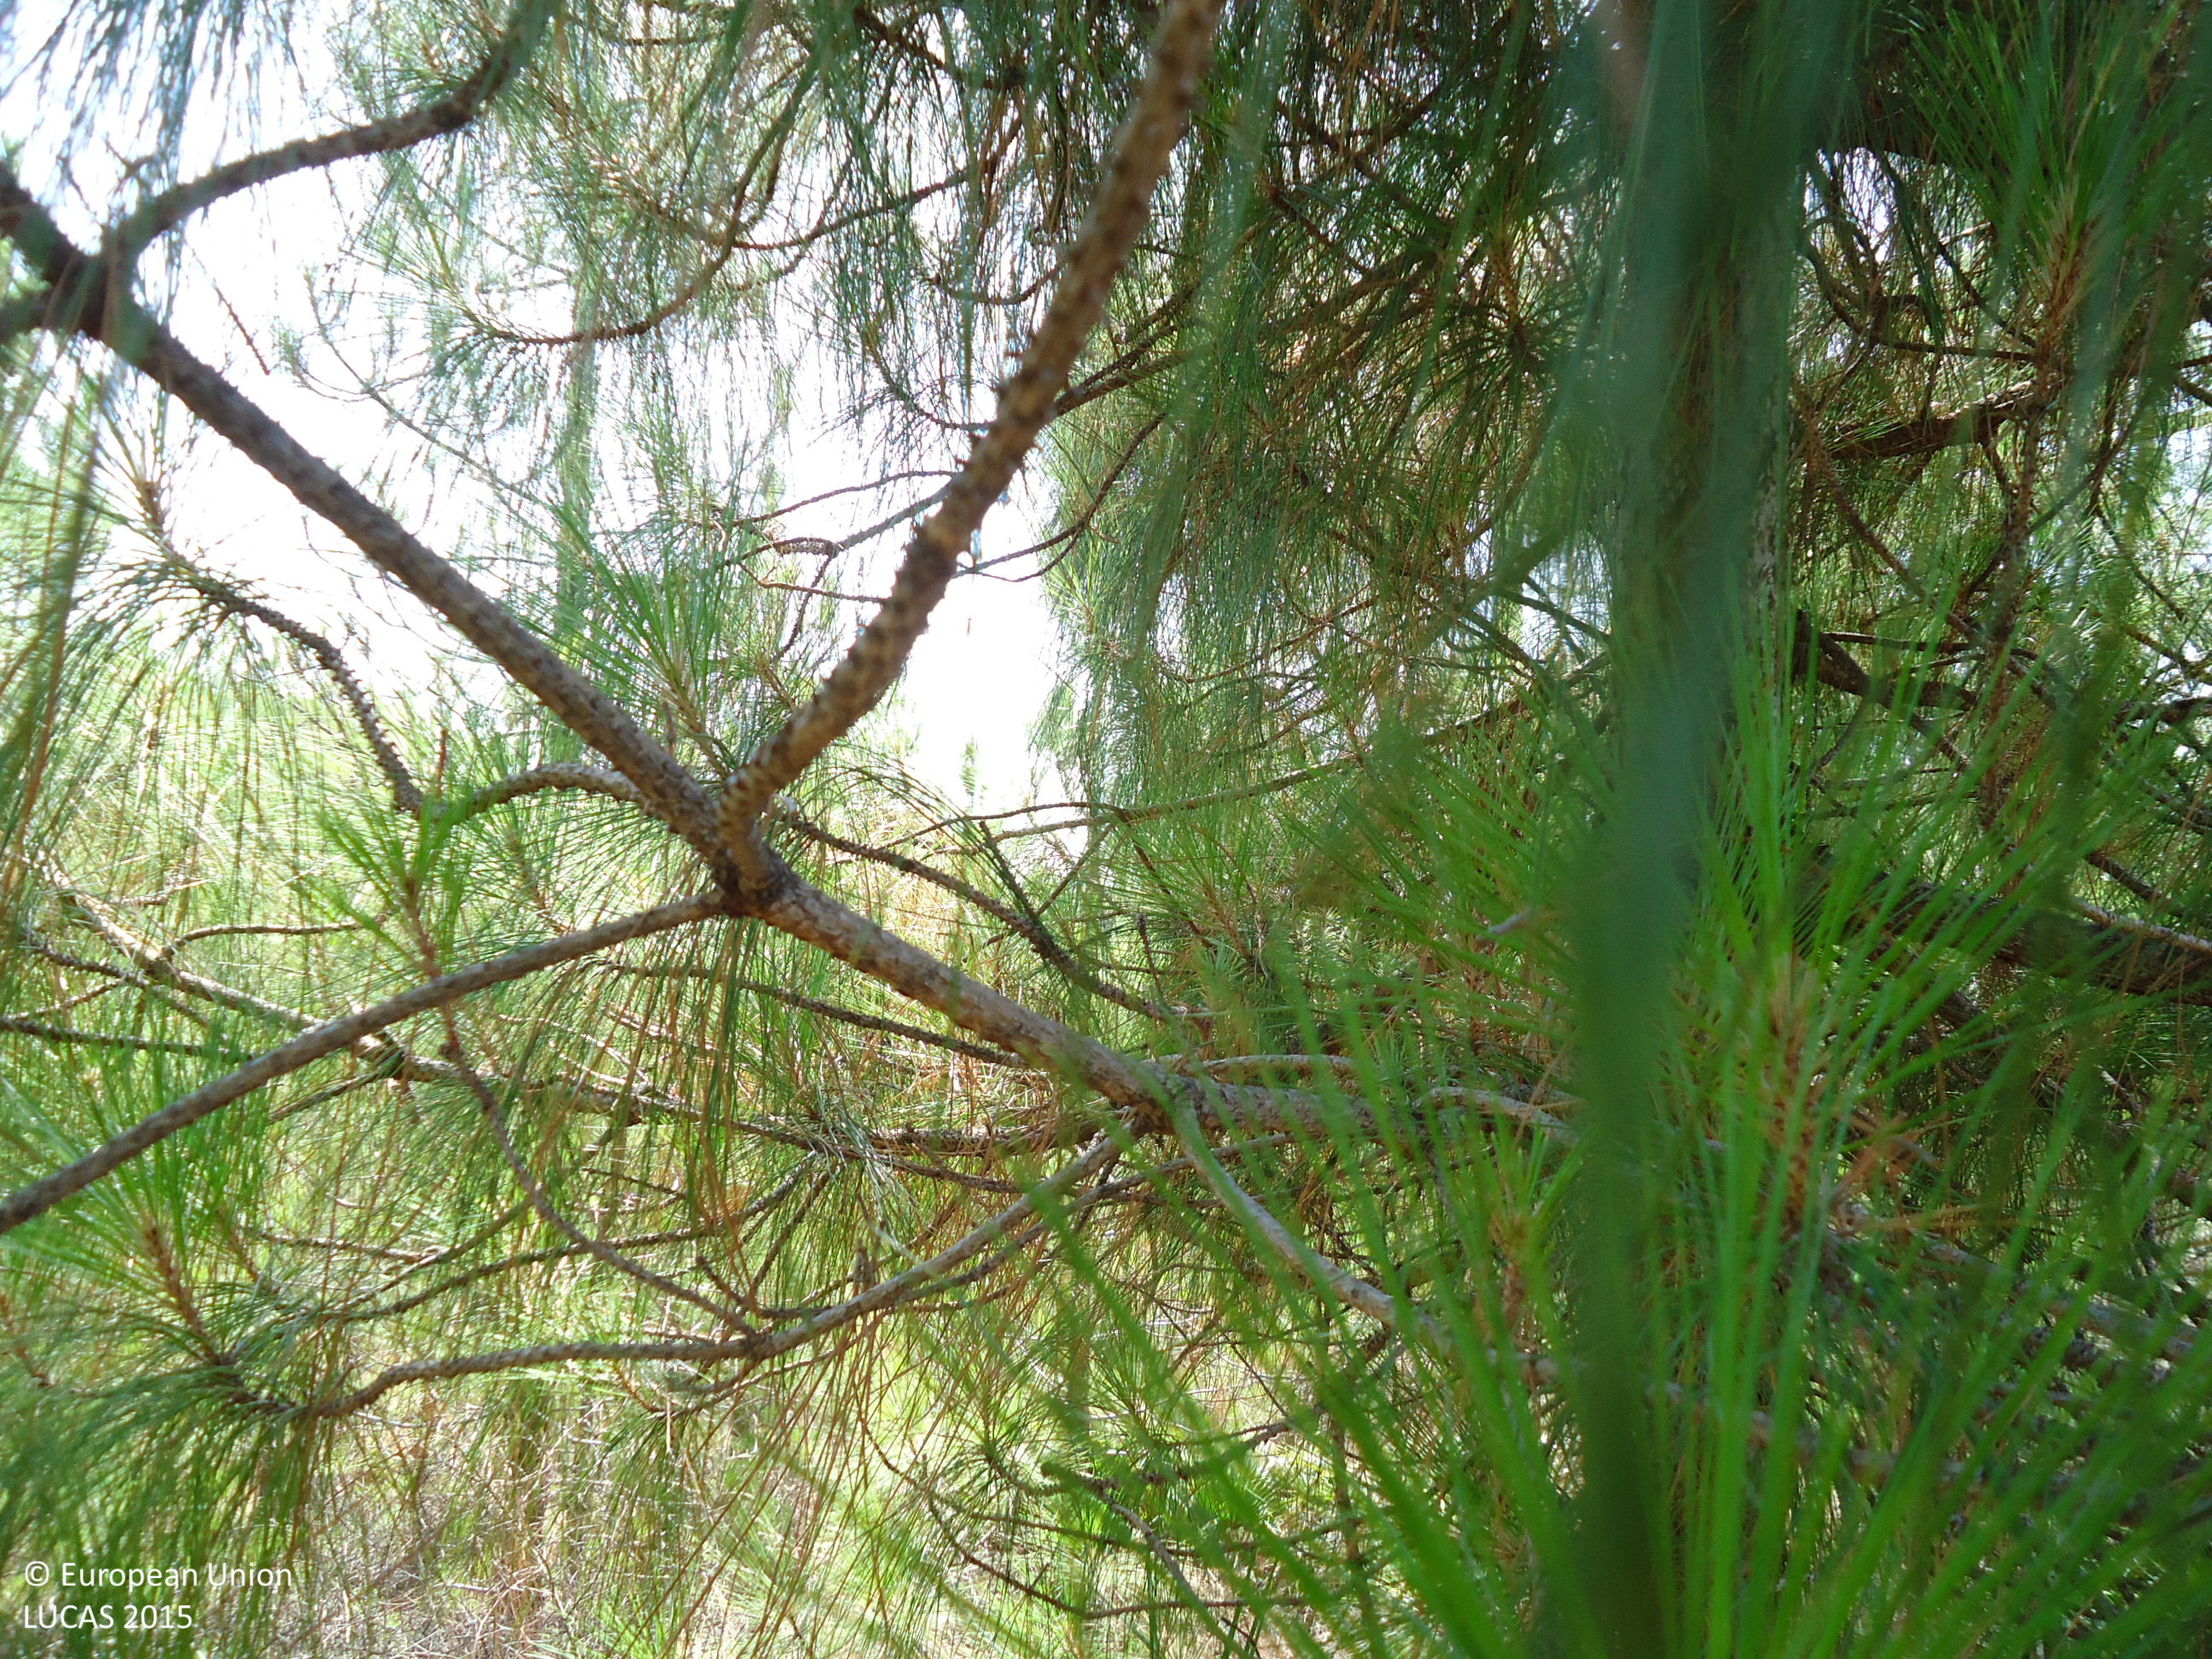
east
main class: Woodland
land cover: Pine dominated coniferous woodland
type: coniferous forest of the mediterranean region
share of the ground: > 75 %
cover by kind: coniferous forest trees 85 %, shrubs 15 %
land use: Forestry
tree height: > 5 m
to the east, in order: Pine dominated coniferous woodland; Tracks; Pine dominated coniferous woodland; Shrubland with sparse tree cover; Shrubland without tree cover; Tracks; Groves; Grassland without tree/shrub cover; Paved roads, cycling and walking lanes; Grassland without tree/shrub cover
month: July
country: ES
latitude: 36.5108
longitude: -4.6720
